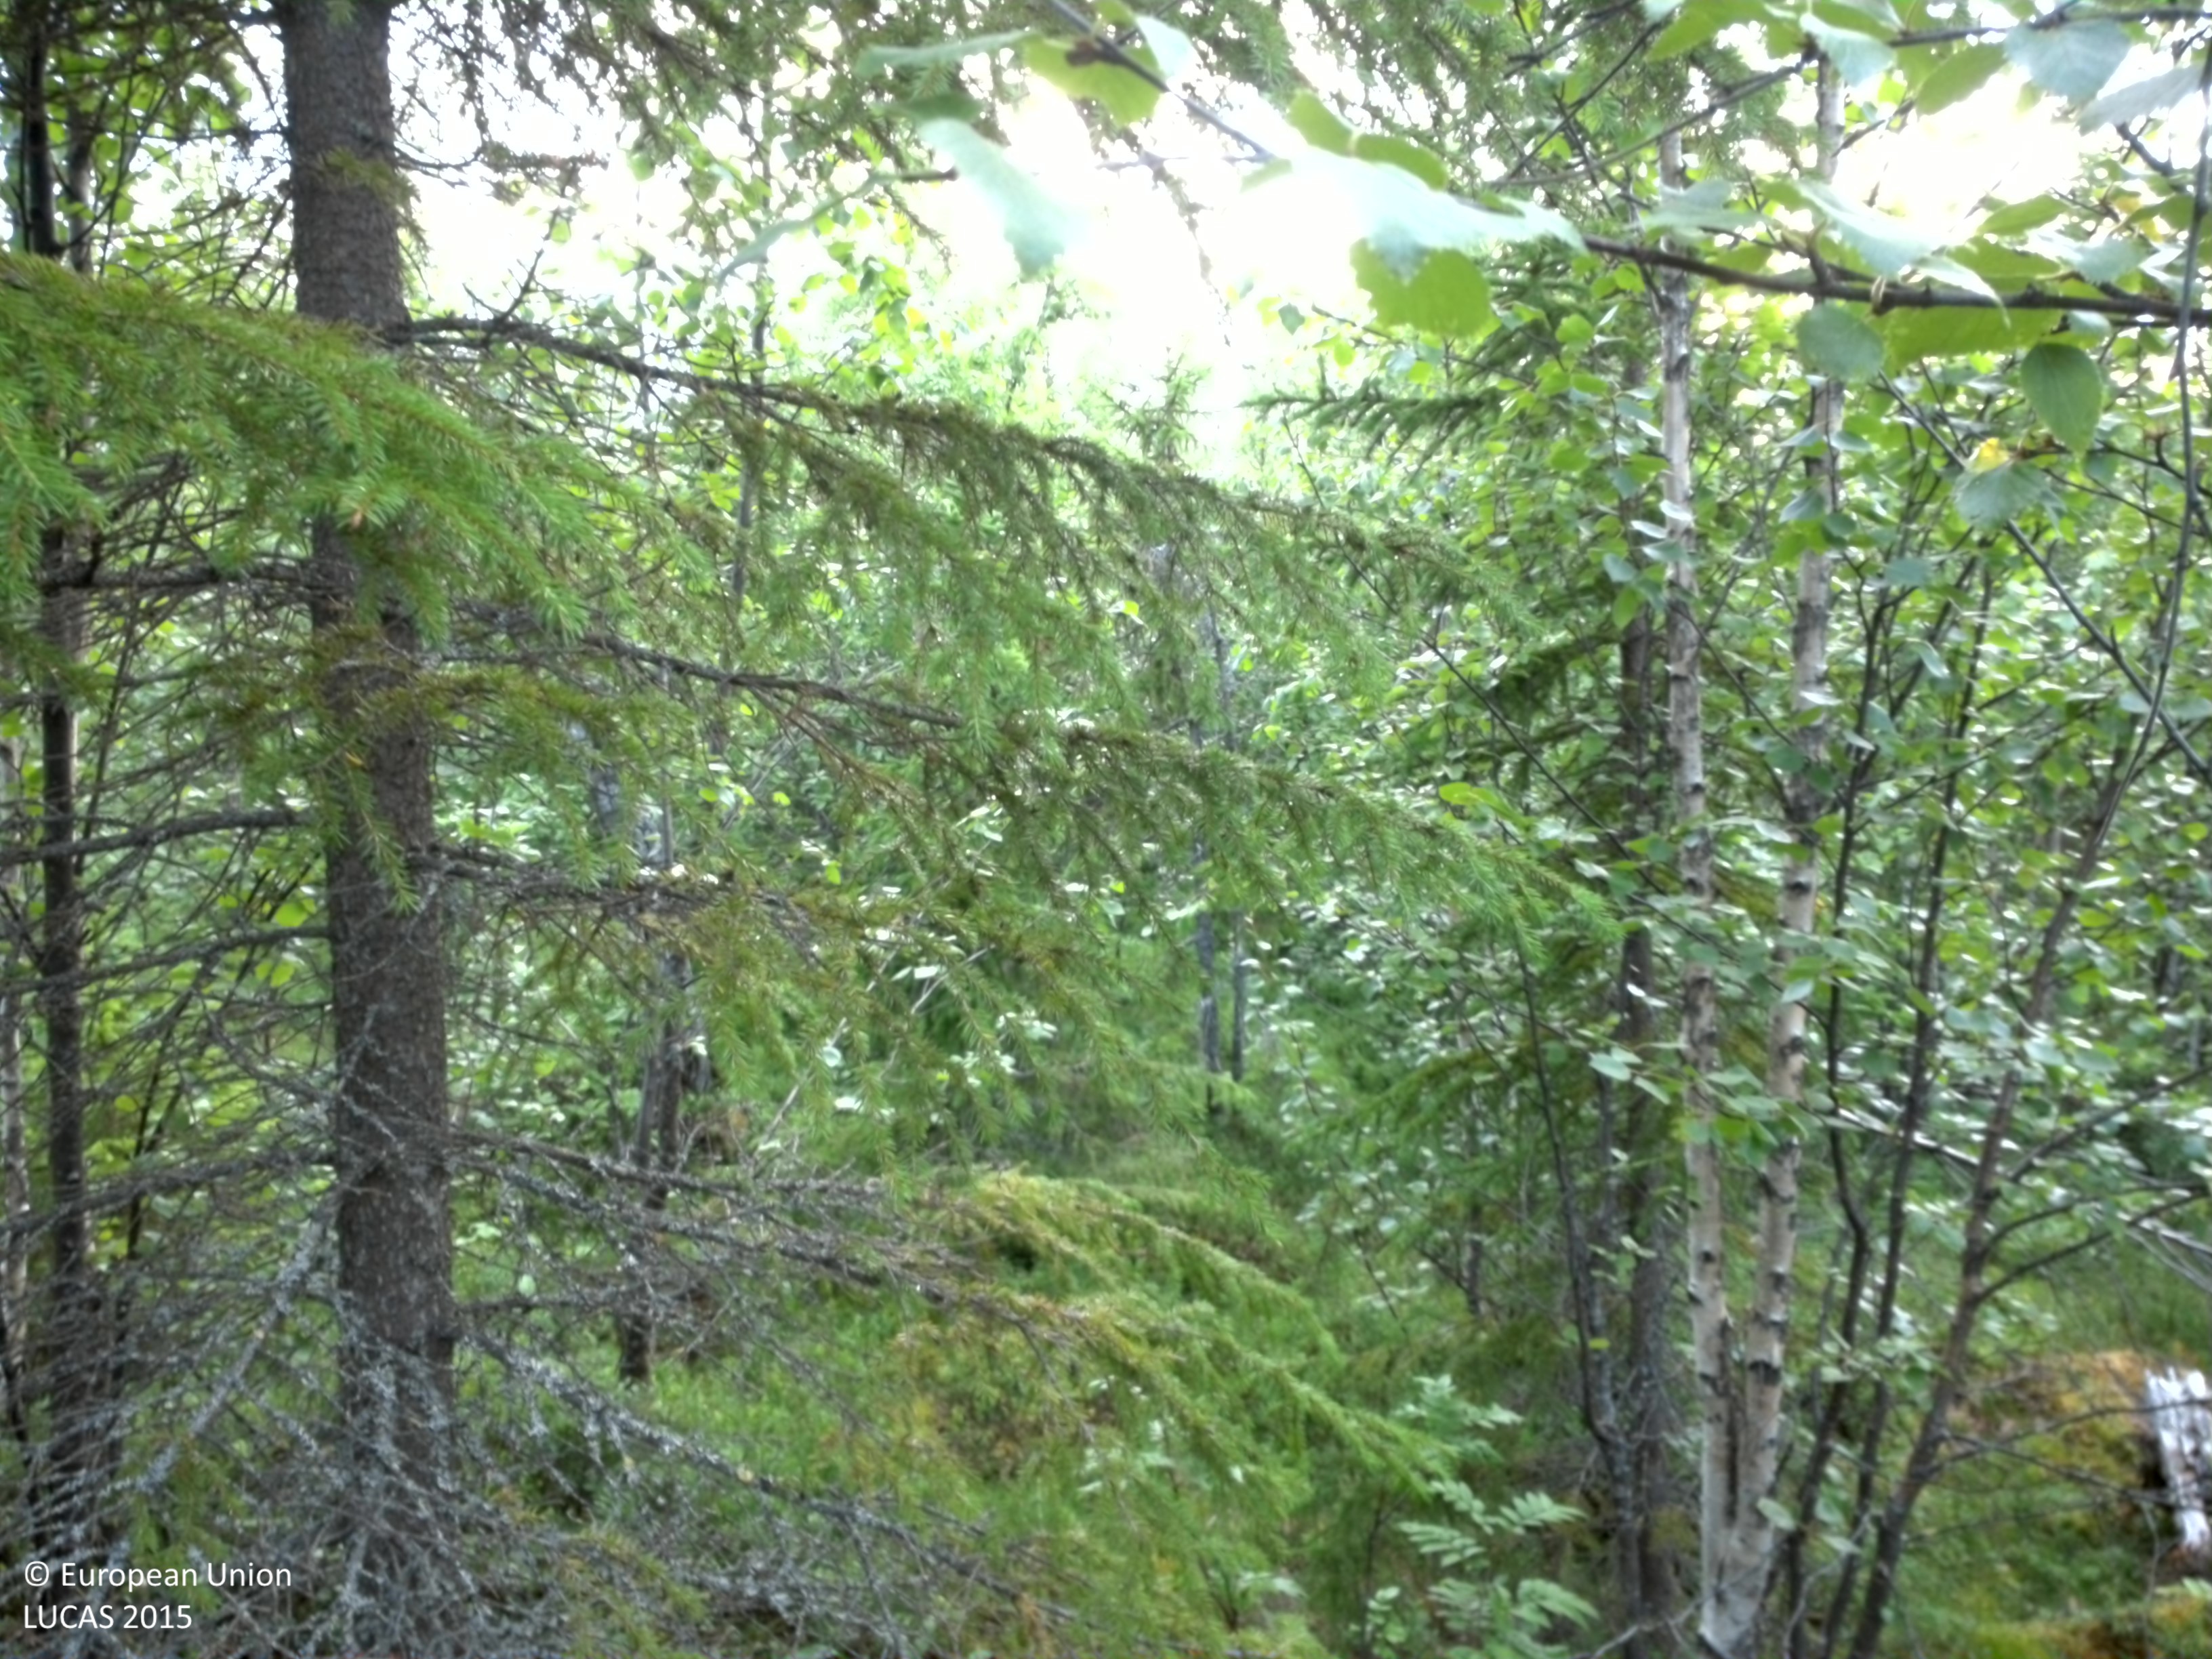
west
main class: Woodland
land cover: Spruce dominated mixed woodland
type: boreal forest
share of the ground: 25 - 50 %
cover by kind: shrubs 55 %, broadleaved forest trees 25 %, coniferous forest trees 10 %, herbaceous plants 5 %, lichens and mosses 5 %
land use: Forestry
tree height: > 5 m
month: August
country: SE
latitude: 64.8621
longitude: 16.0638
